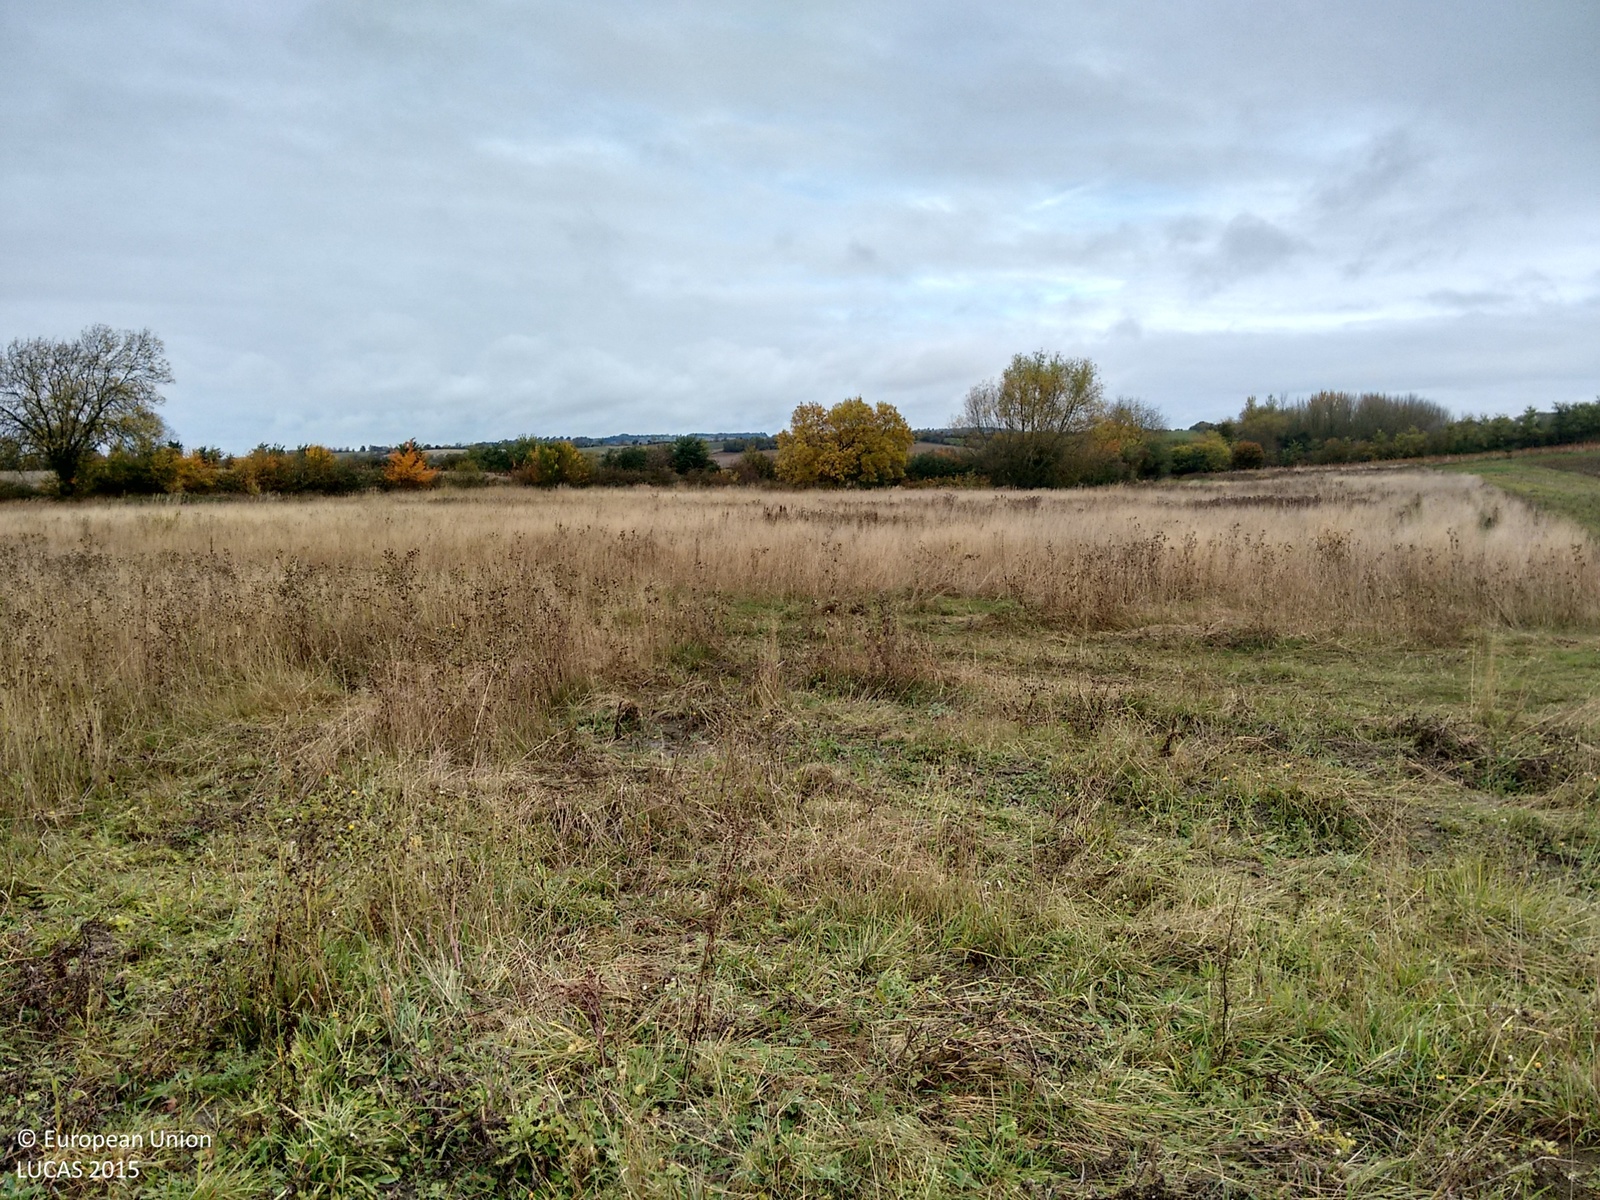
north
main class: Grassland
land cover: Grassland without tree/shrub cover
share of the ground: > 75 %
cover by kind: herbaceous plants 100 %
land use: Agriculture (excluding fallow land and kitchen gardens)
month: October
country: GB
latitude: 52.0151
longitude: -1.6959
